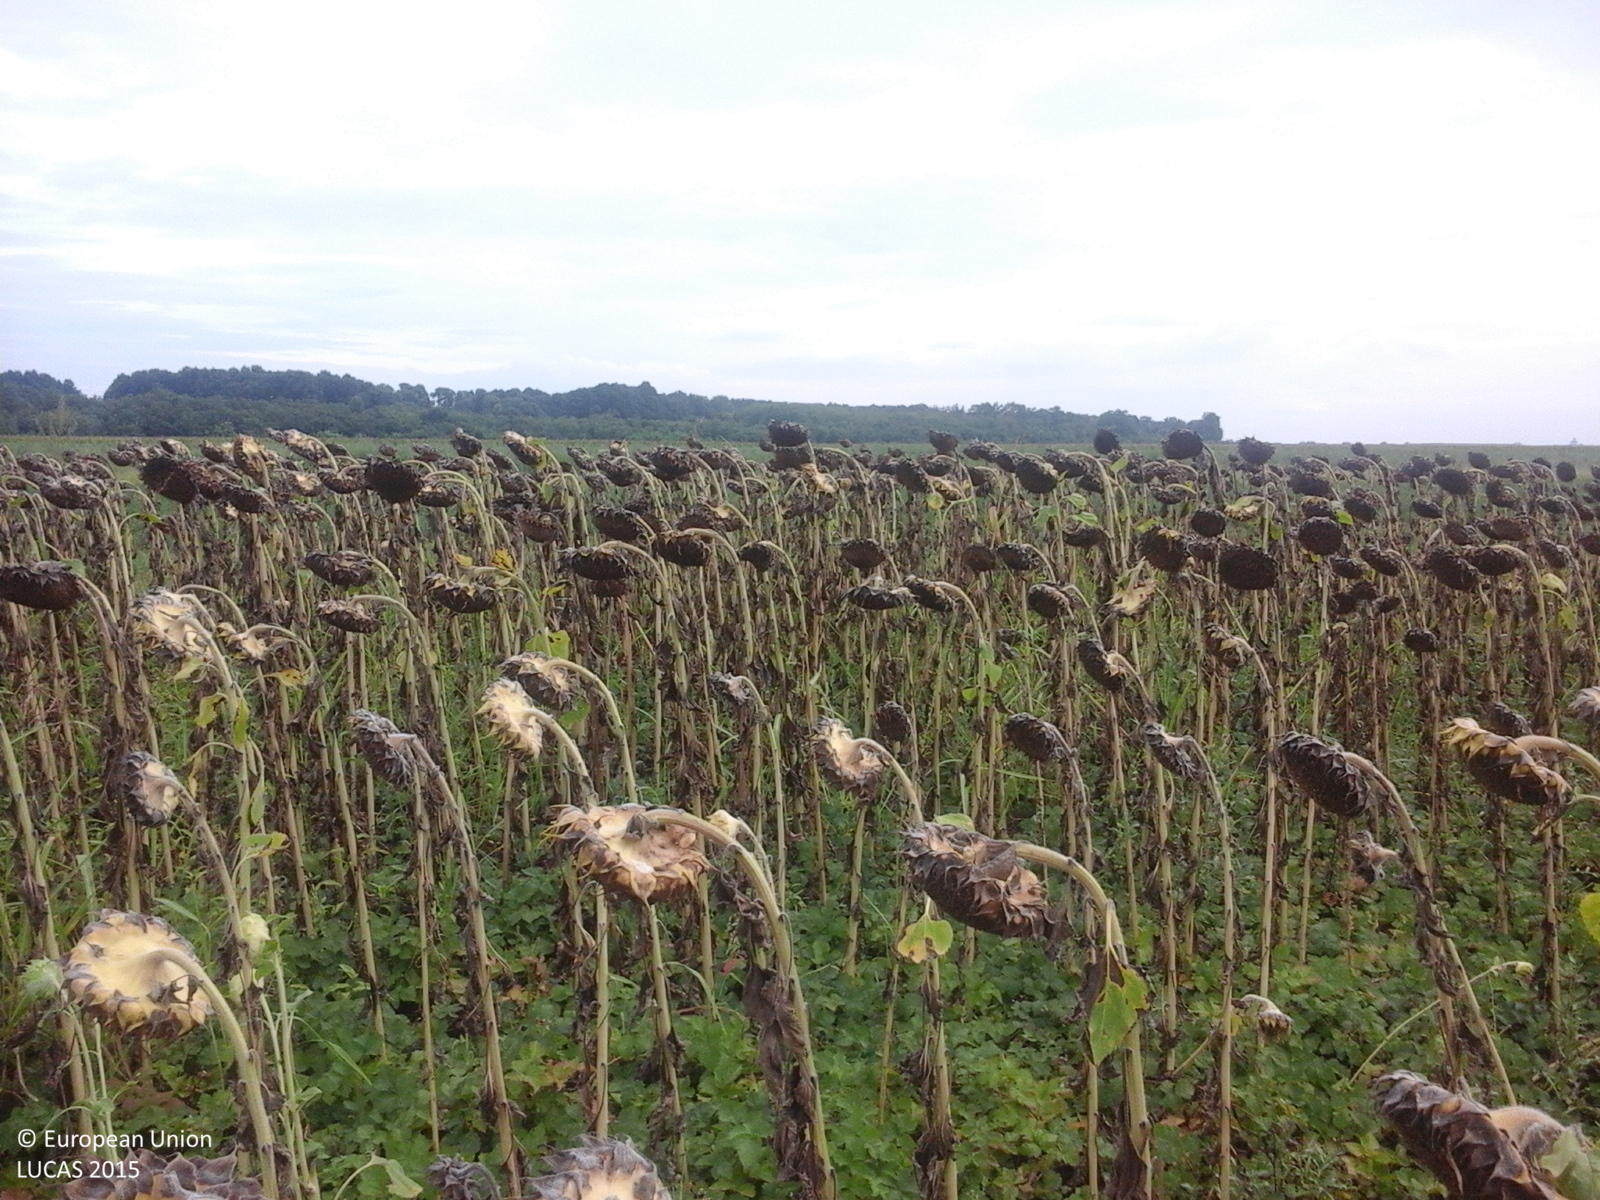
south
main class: Cropland
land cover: Sunflower
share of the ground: > 75 %
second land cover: Spontaneously vegetated surfaces
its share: 50 - 75 %
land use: Agriculture (excluding fallow land and kitchen gardens)
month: August
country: RO
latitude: 46.0168
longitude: 20.8386
